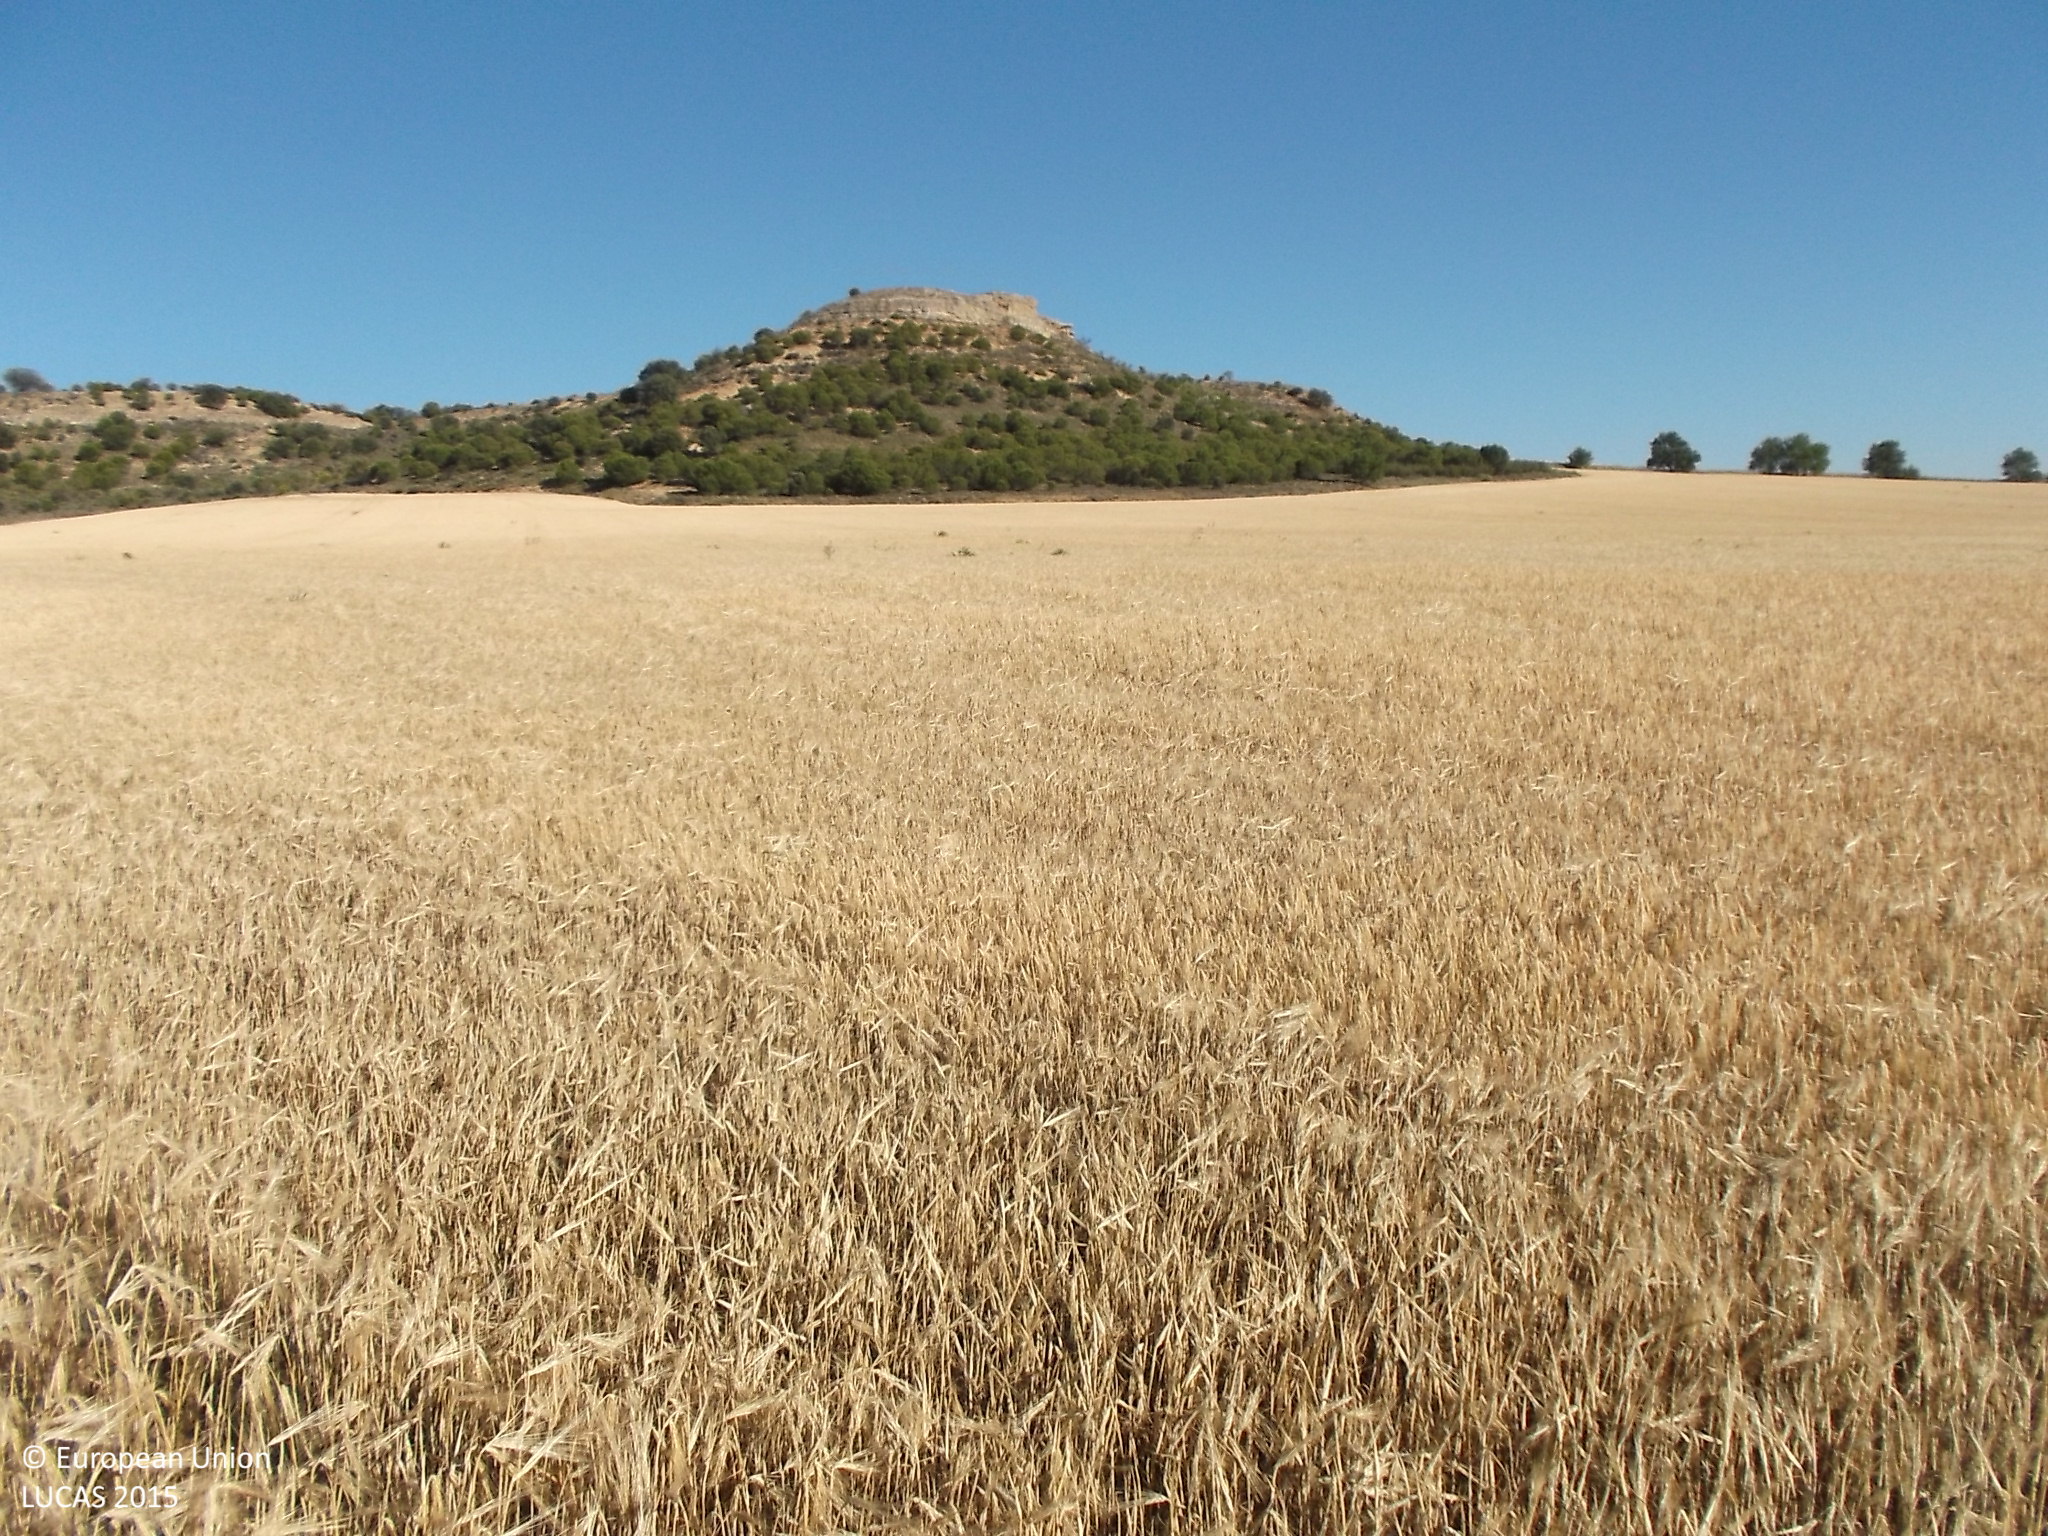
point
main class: Cropland
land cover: Barley
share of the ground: > 75 %
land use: Agriculture (excluding fallow land and kitchen gardens)
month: June
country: ES
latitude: 41.2962
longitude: -5.3254
